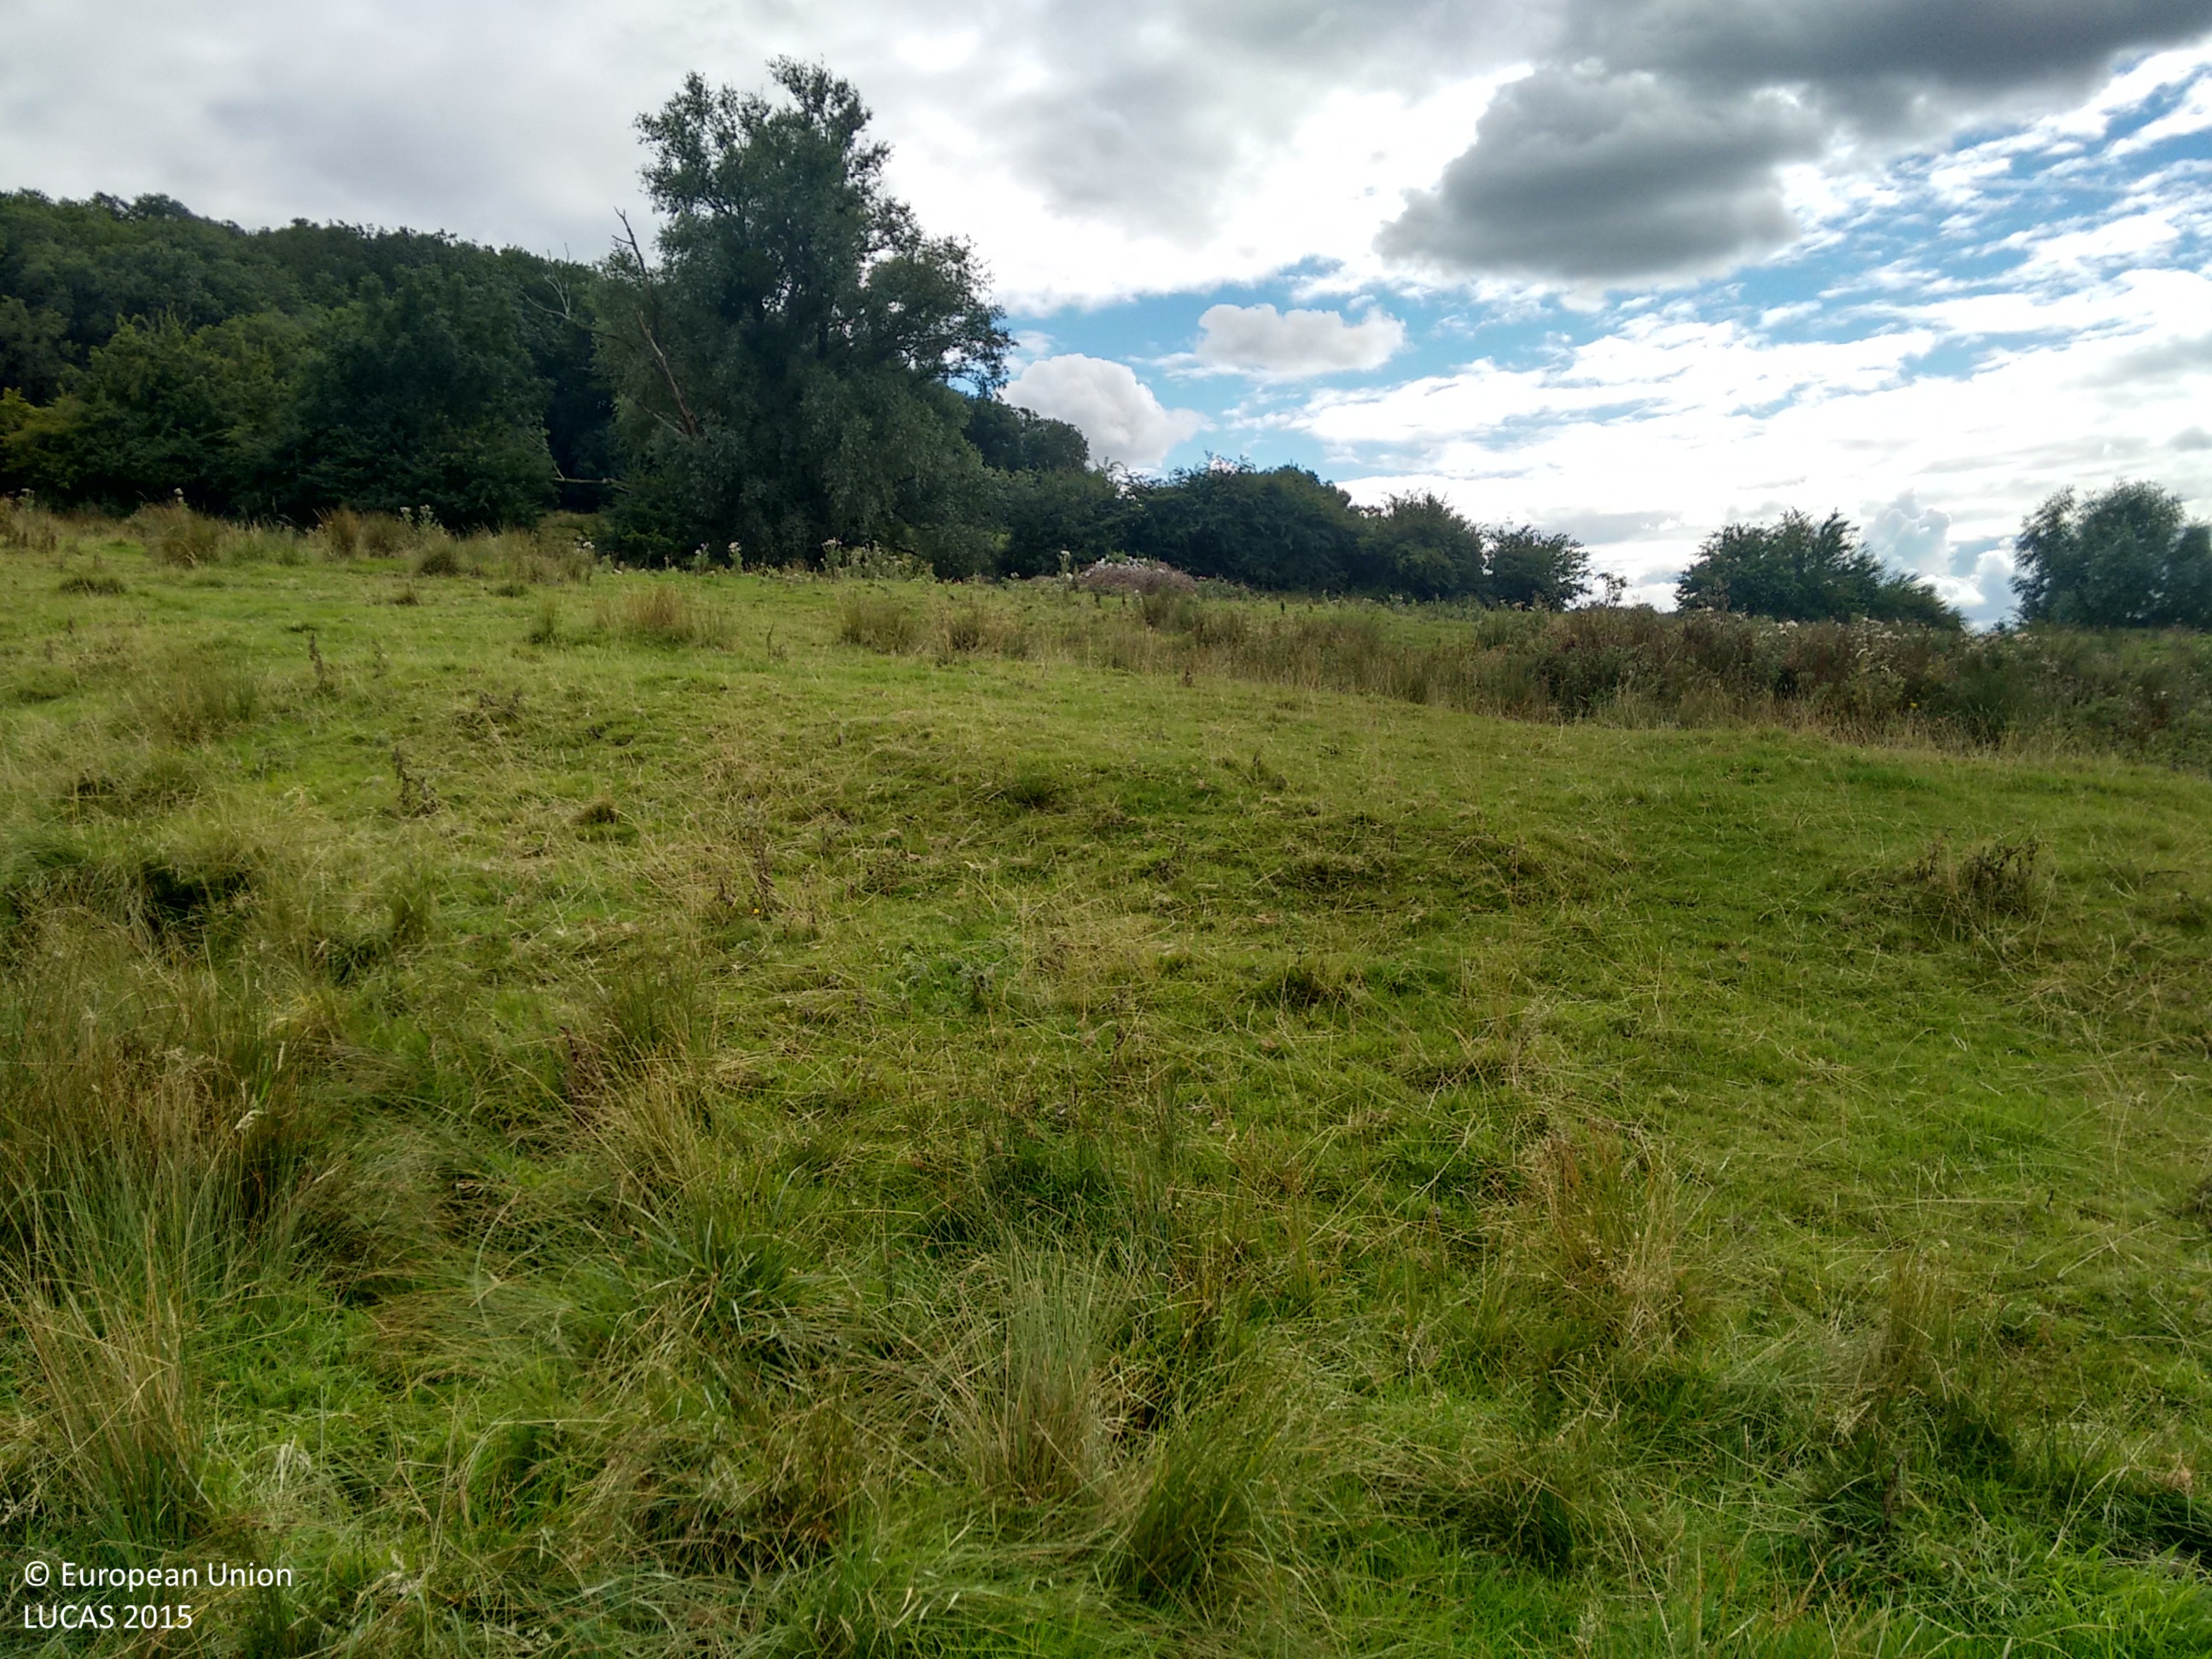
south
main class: Grassland
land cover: Grassland without tree/shrub cover
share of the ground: > 75 %
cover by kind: herbaceous plants 100 %
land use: Agriculture (excluding fallow land and kitchen gardens)
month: September
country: GB
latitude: 51.9623
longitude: -2.0366
